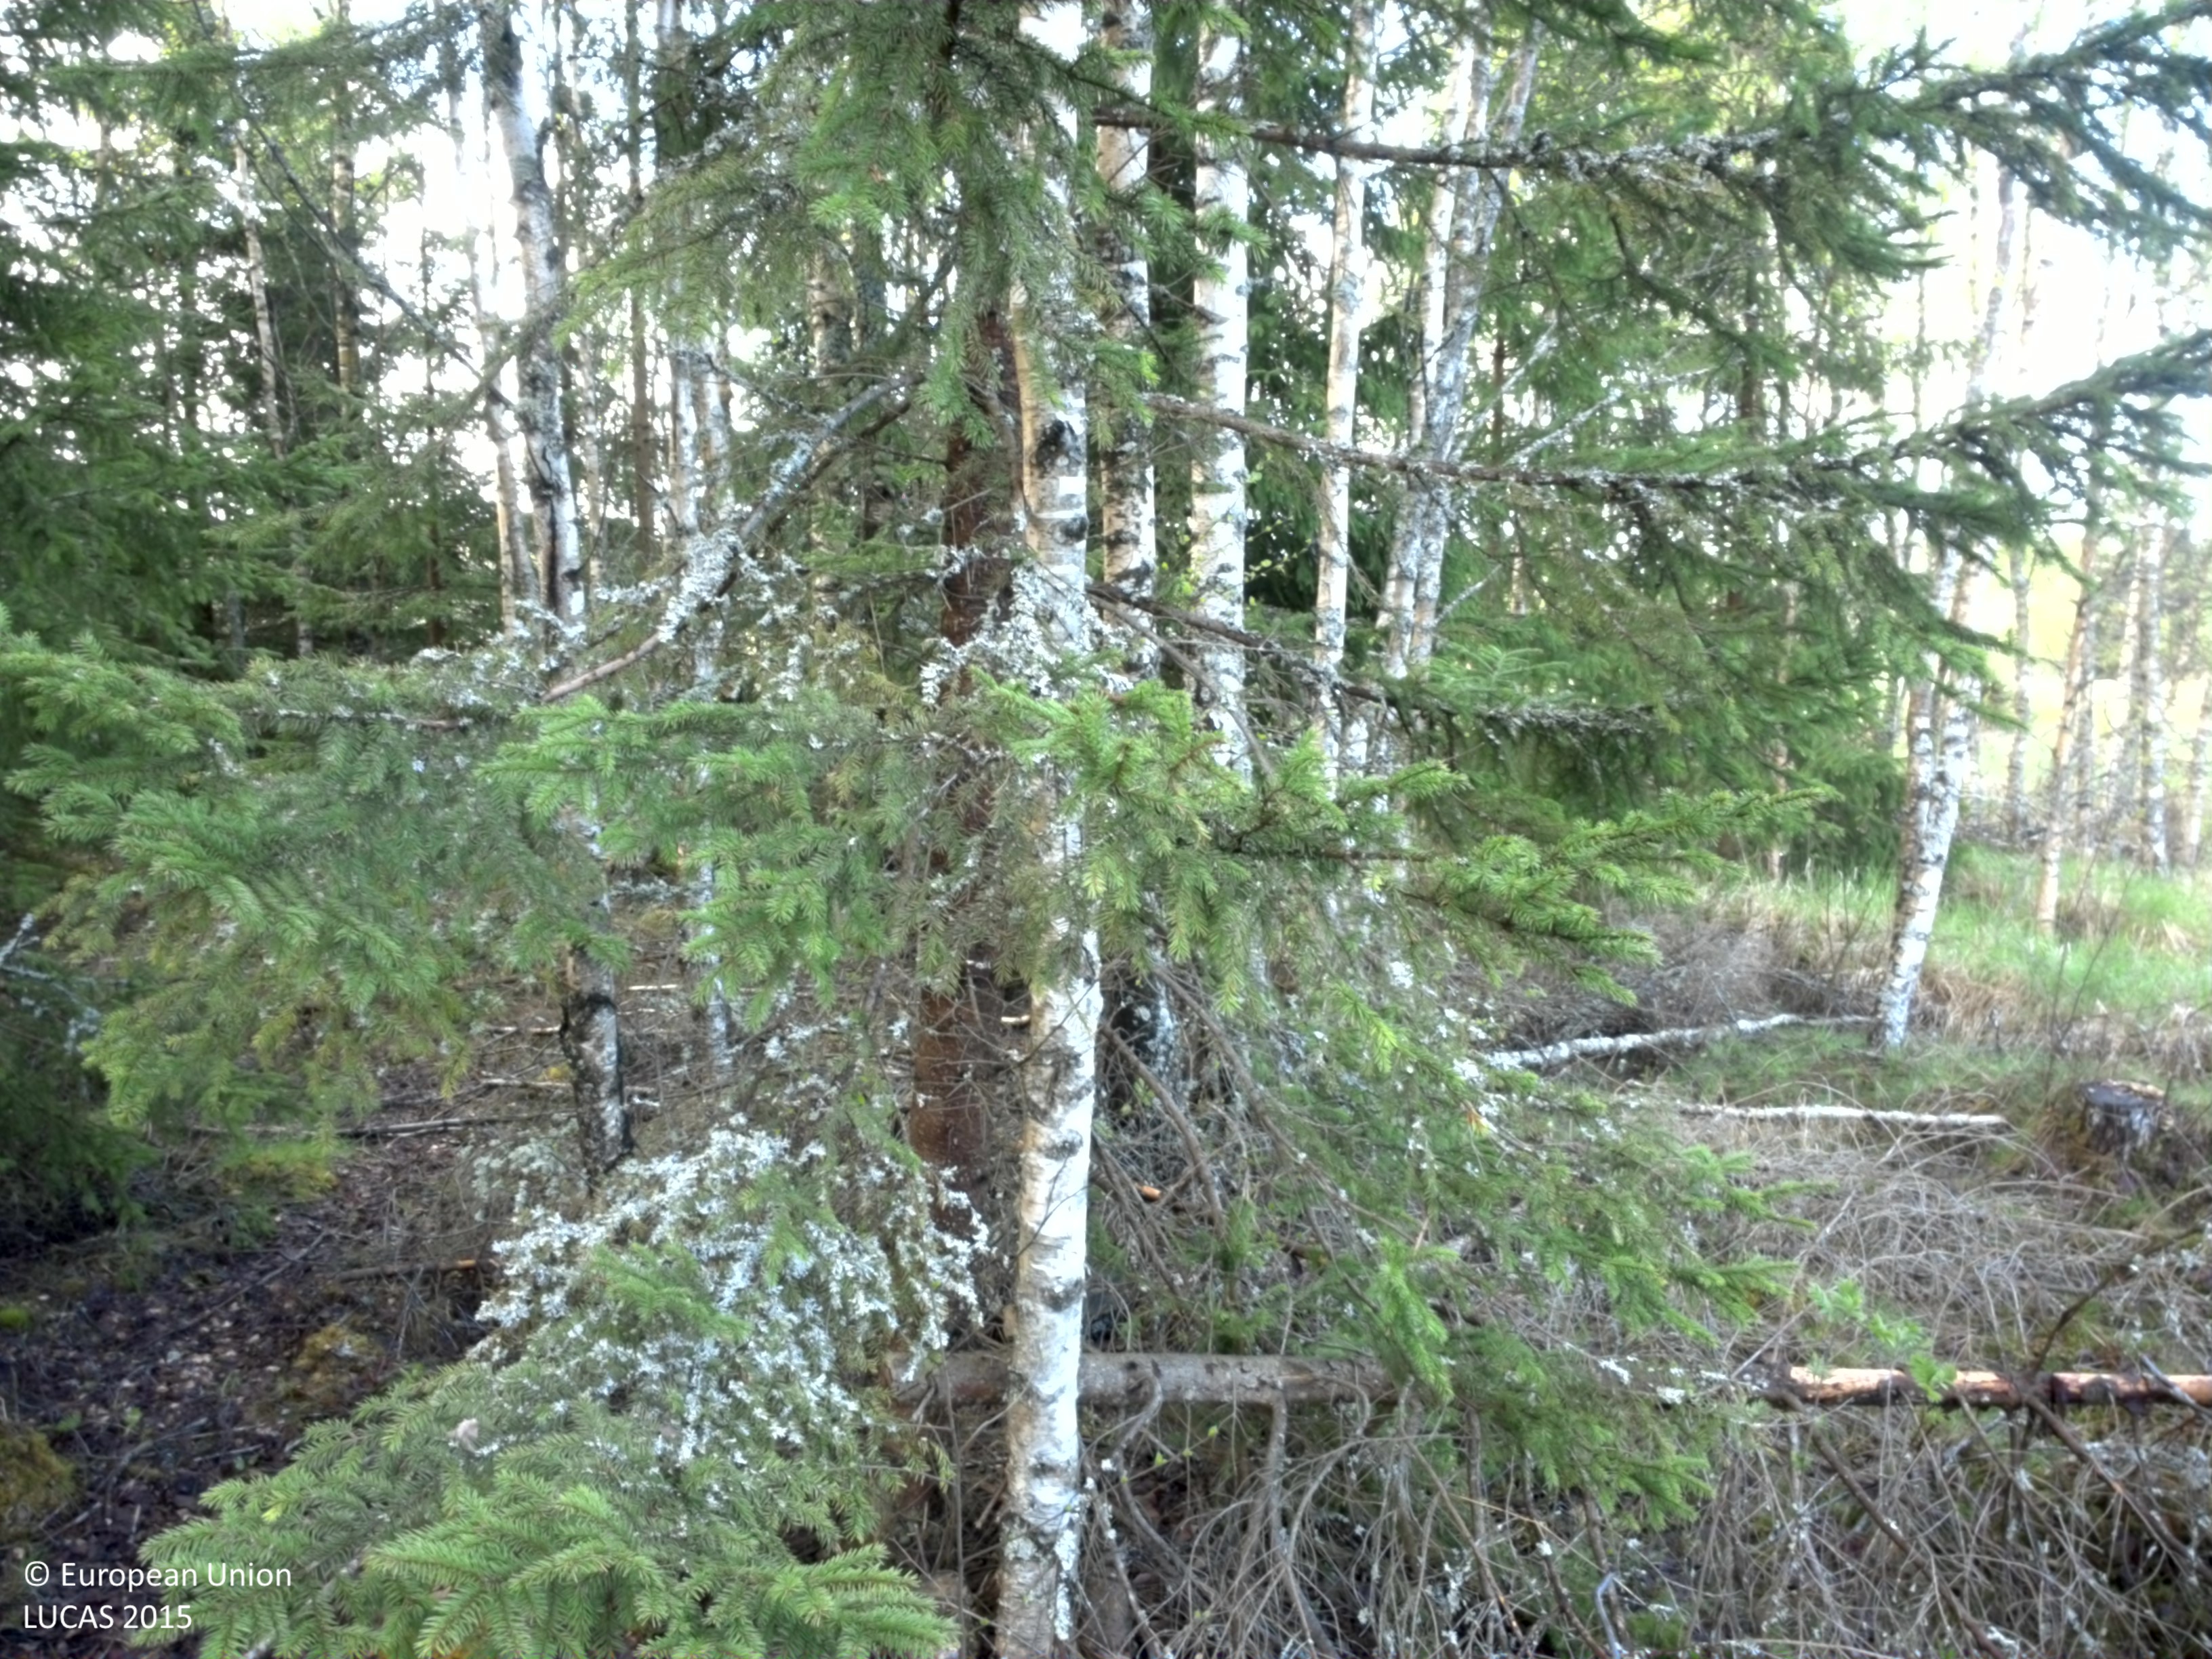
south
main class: Woodland
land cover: Broadleaved woodland
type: hemiboreal forest and nemoral coniferous forest and mixed broadleaved-coniferous forest
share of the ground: 10 - 25 %
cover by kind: herbaceous plants 50 %, shrubs 30 %, broadleaved forest trees 10 %, lichens and mosses 10 %
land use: Electricity, gas and thermal power distribution
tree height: < 5 m
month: May
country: SE
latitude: 59.2905
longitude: 14.1524
